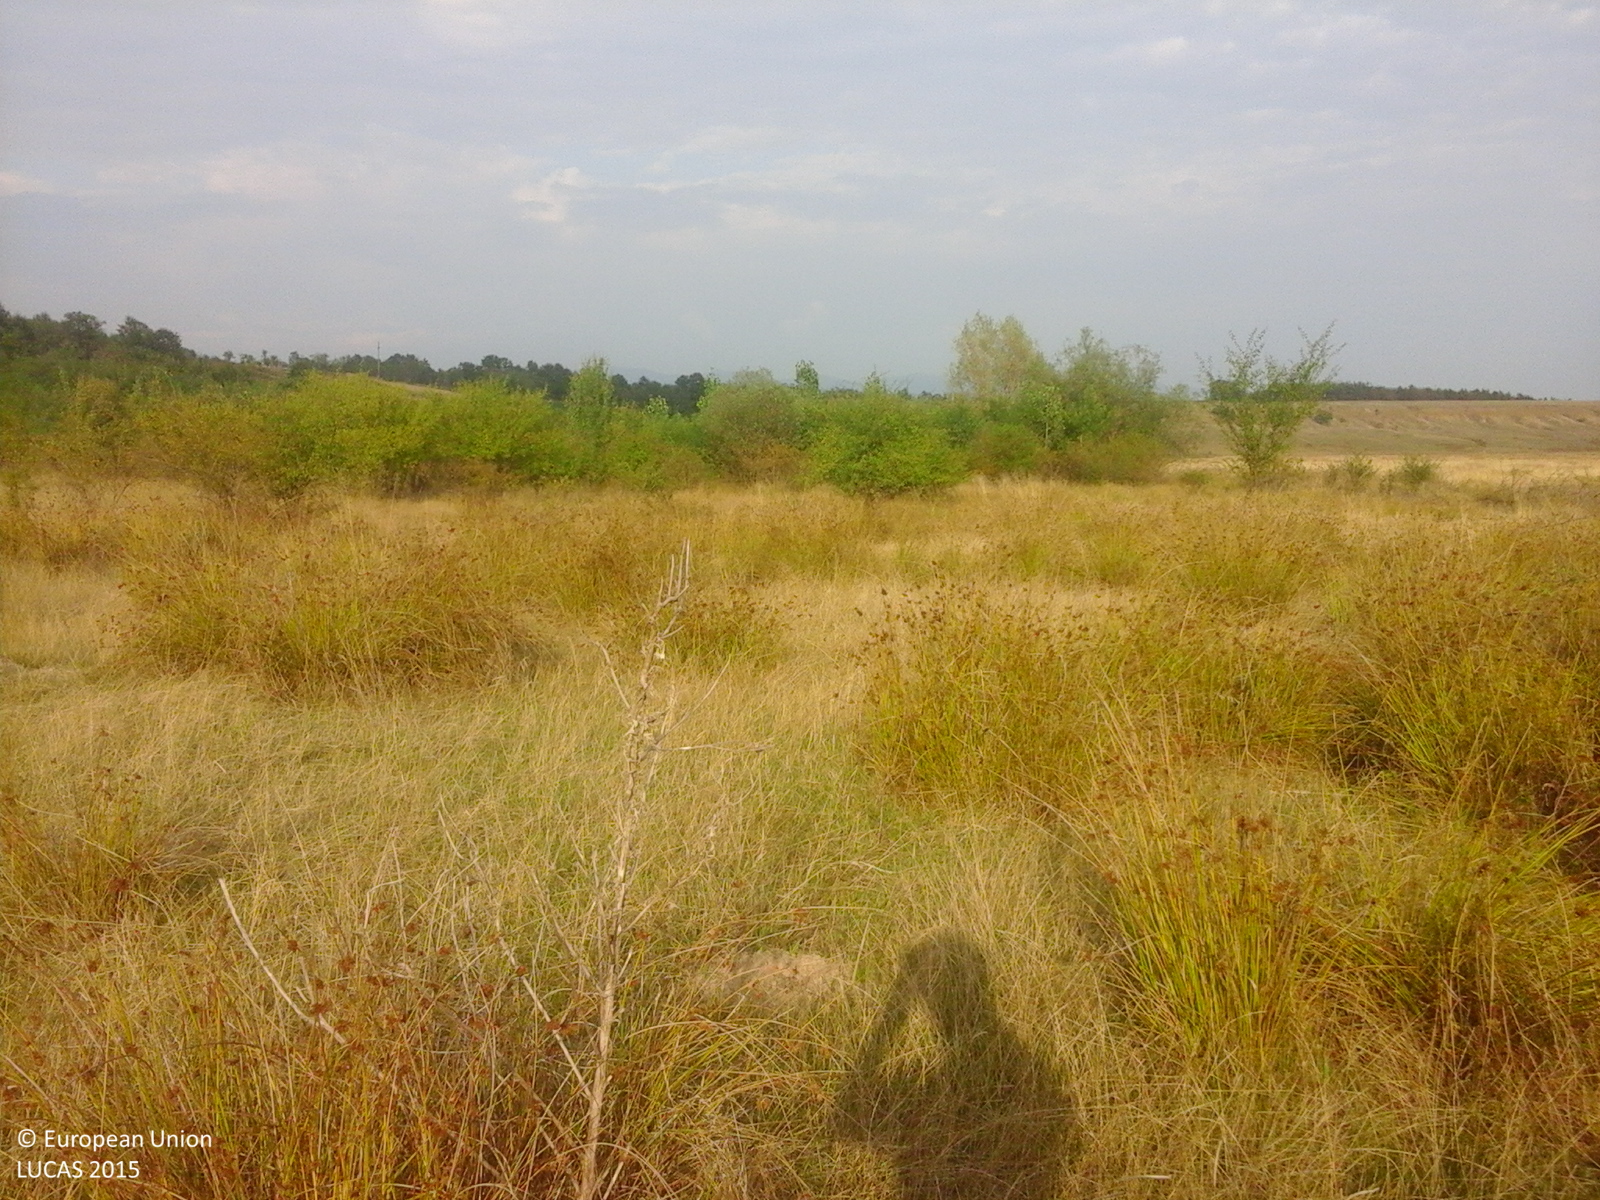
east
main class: Grassland
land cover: Grassland with sparse tree/shrub cover
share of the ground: > 75 %
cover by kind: herbaceous plants 85 %, shrubs 10 %, broadleaved forest trees 5 %
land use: Agriculture (excluding fallow land and kitchen gardens)
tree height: < 5 m
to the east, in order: Grassland with sparse tree/shrub cover; Ditches and canals; Spontaneously vegetated surfaces; Grassland without tree/shrub cover
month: August
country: RO
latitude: 46.4958
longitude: 21.9656
